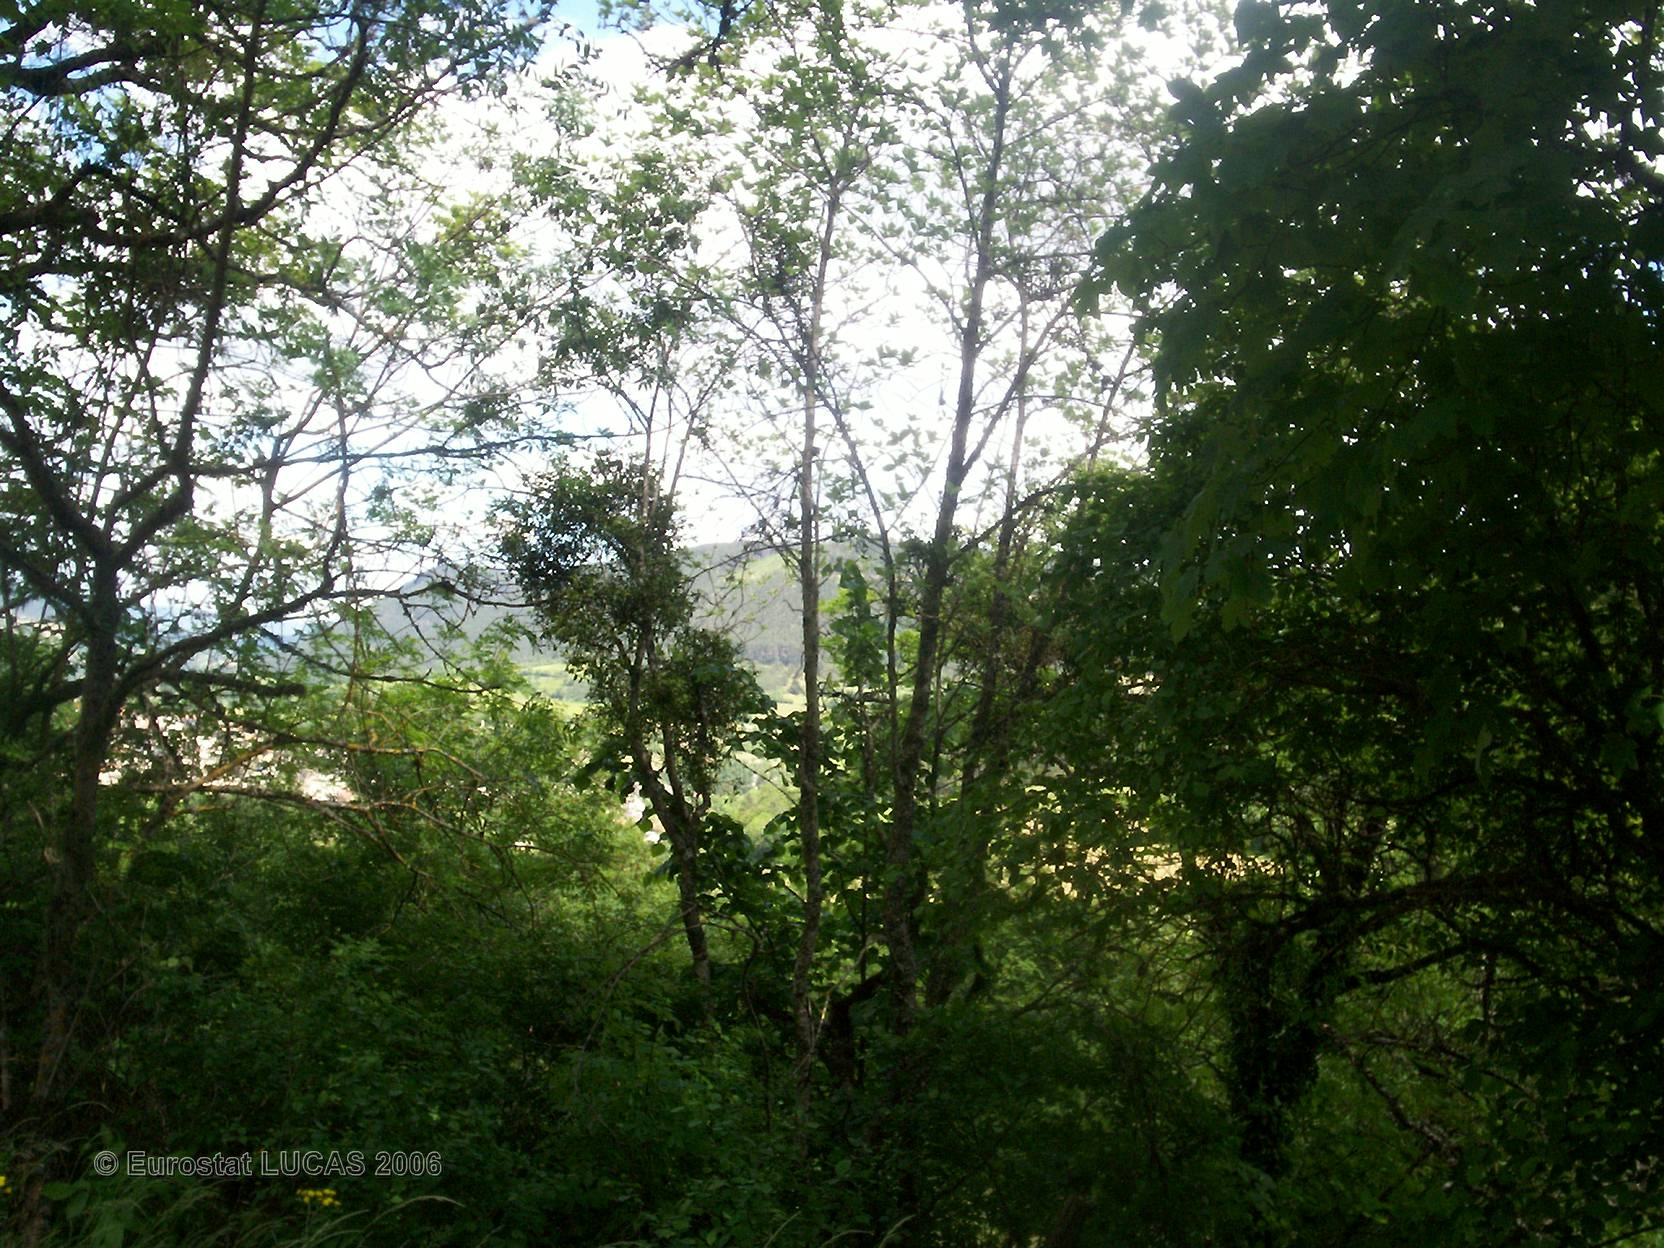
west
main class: Woodland
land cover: Mixed forest
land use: Unused
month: June
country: FR
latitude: 44.4616
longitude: 3.3310
